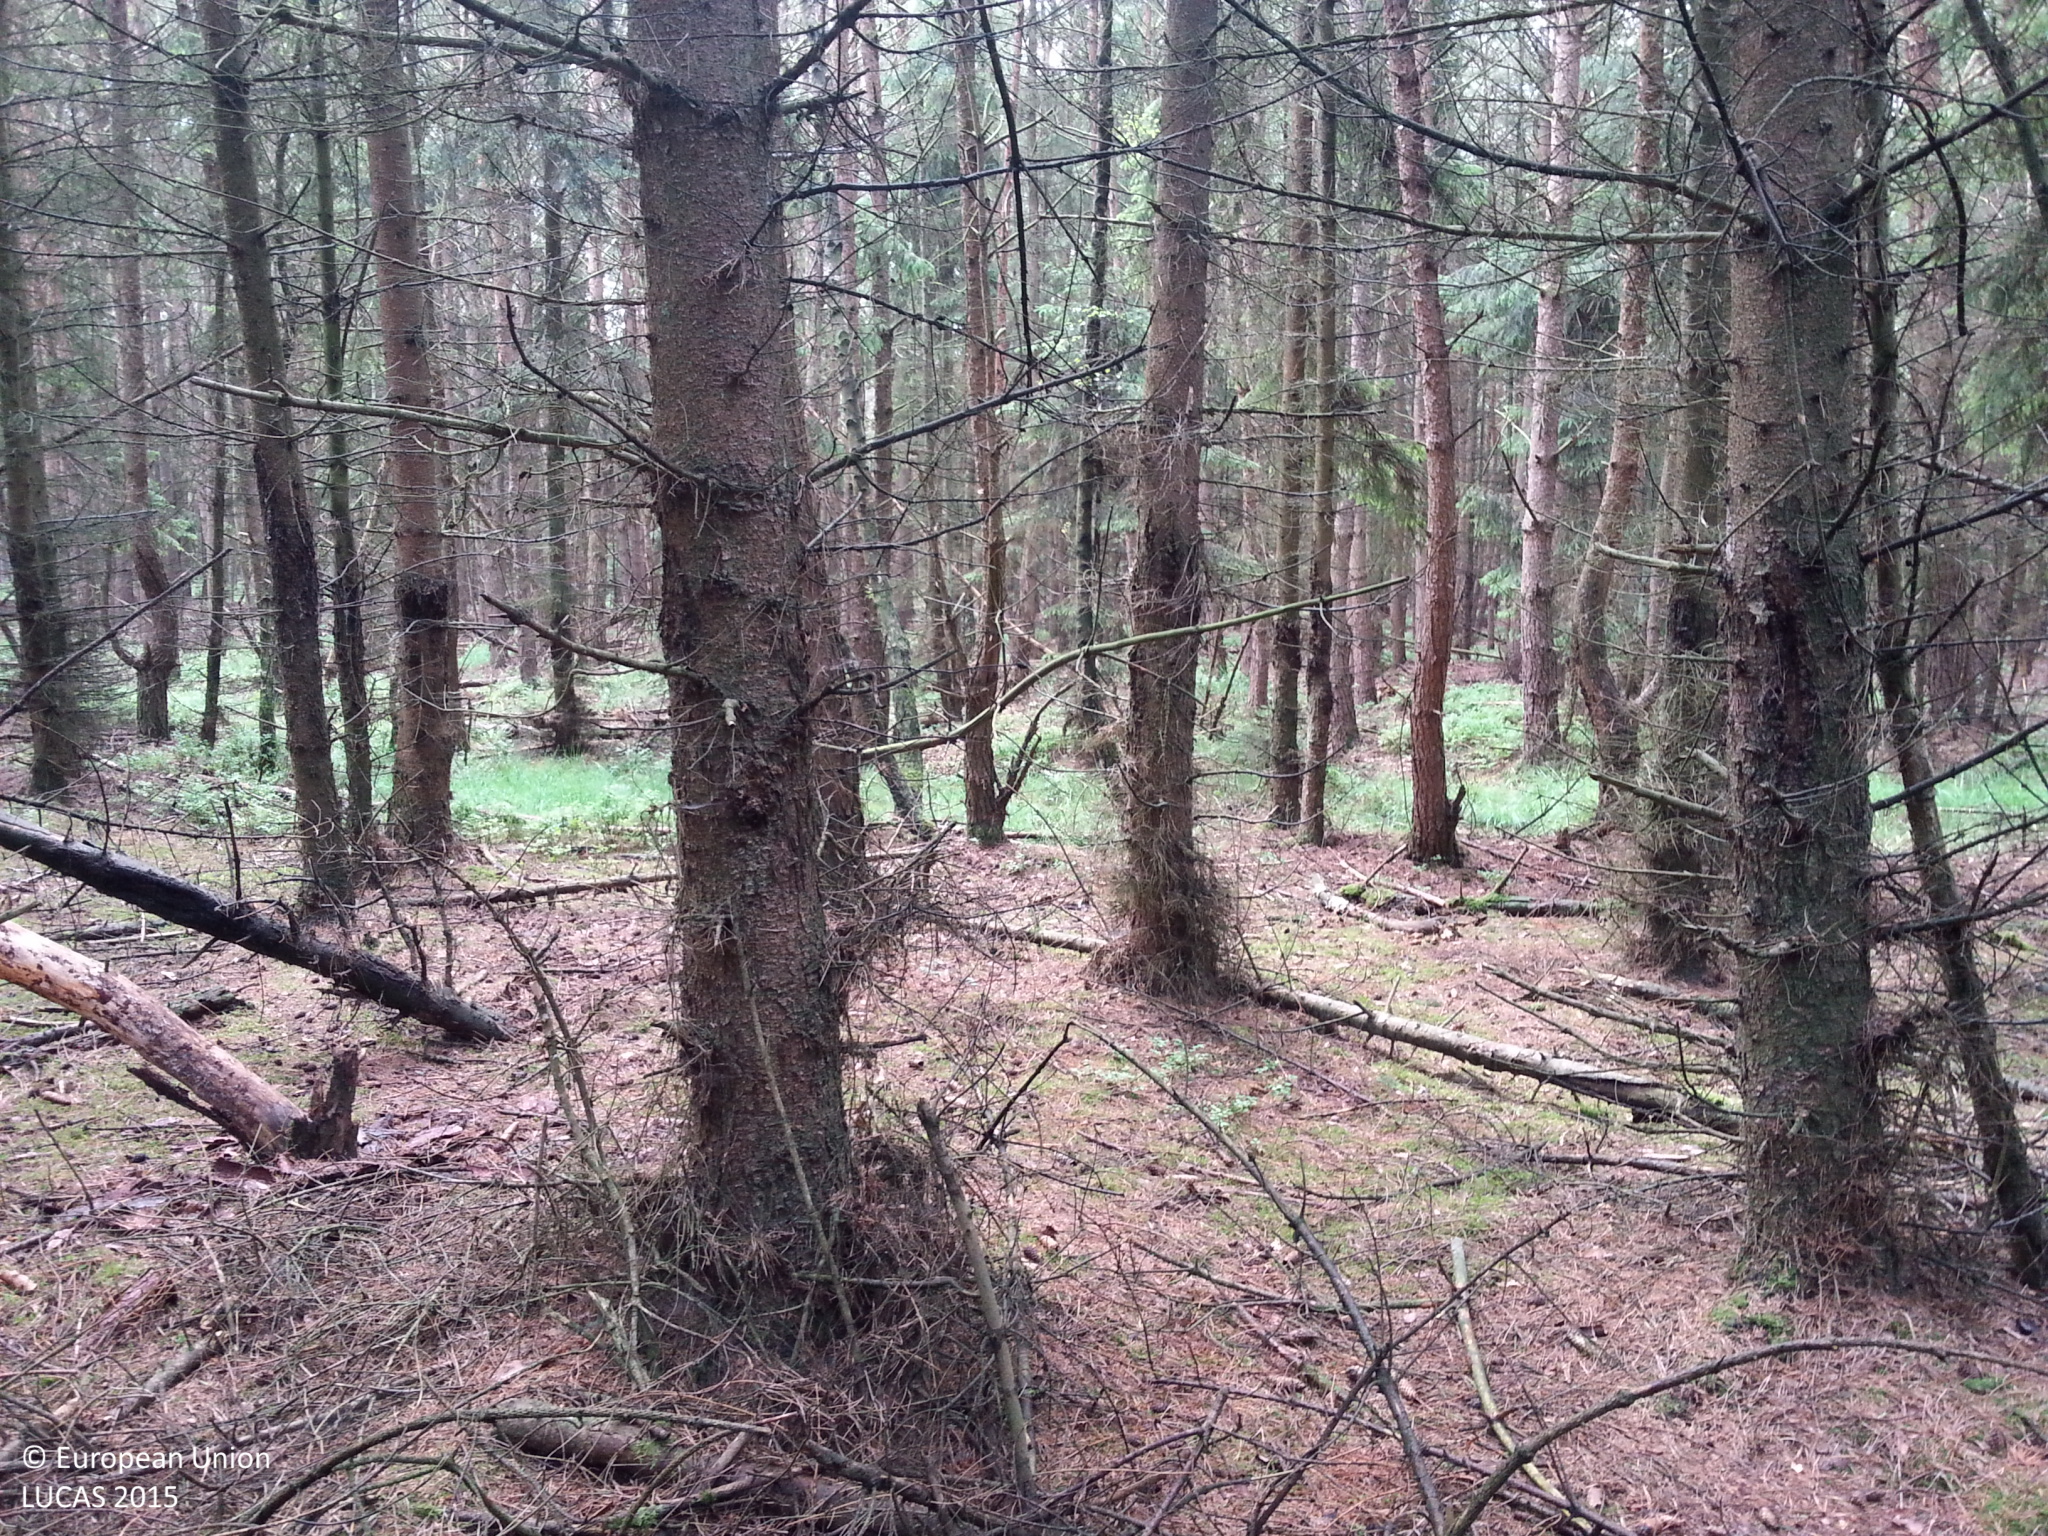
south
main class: Woodland
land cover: Spruce dominated coniferous woodland
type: boreal forest
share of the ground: > 75 %
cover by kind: coniferous forest trees 80 %, lichens and mosses 10 %, unconsolidated bare surface 10 %
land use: Forestry
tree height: > 5 m
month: July
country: DE
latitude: 53.2358
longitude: 11.0333
